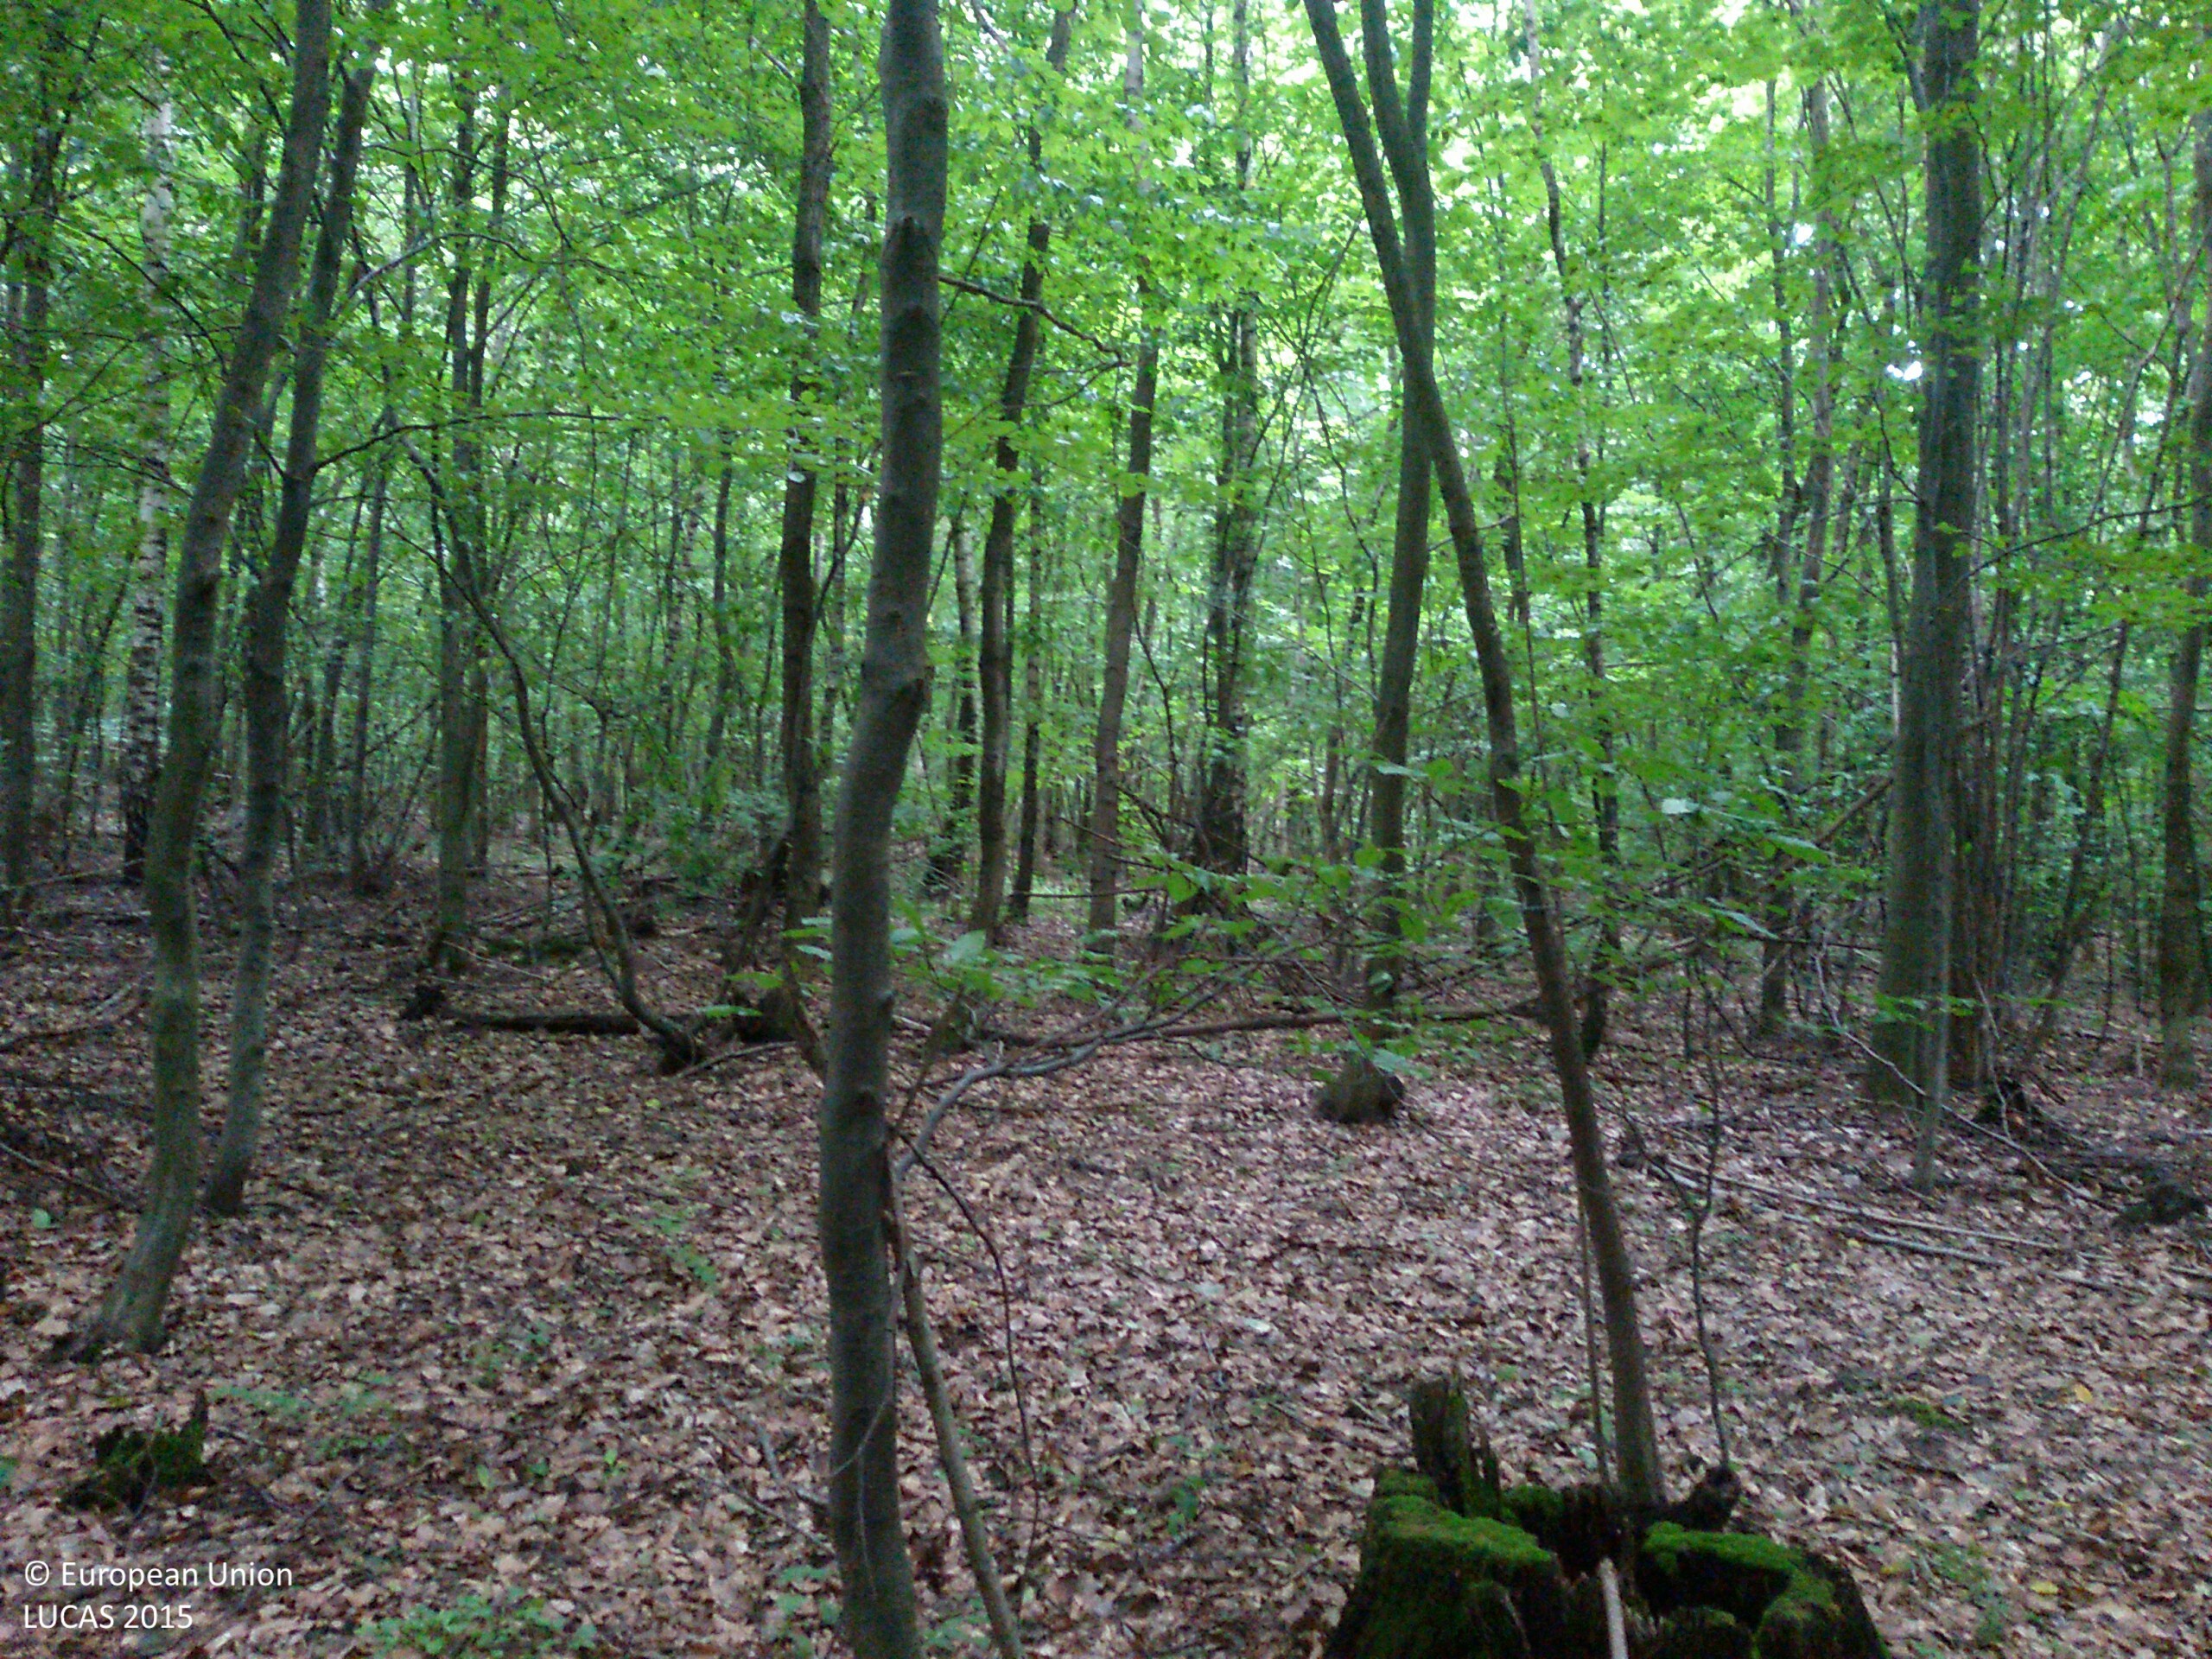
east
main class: Woodland
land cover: Broadleaved woodland
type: mesophytic deciduous forest
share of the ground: > 75 %
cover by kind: broadleaved forest trees 100 %
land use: Forestry
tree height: > 5 m
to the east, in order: Broadleaved woodland; Tracks; Broadleaved woodland
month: July
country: PL
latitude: 50.4315
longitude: 20.4124
